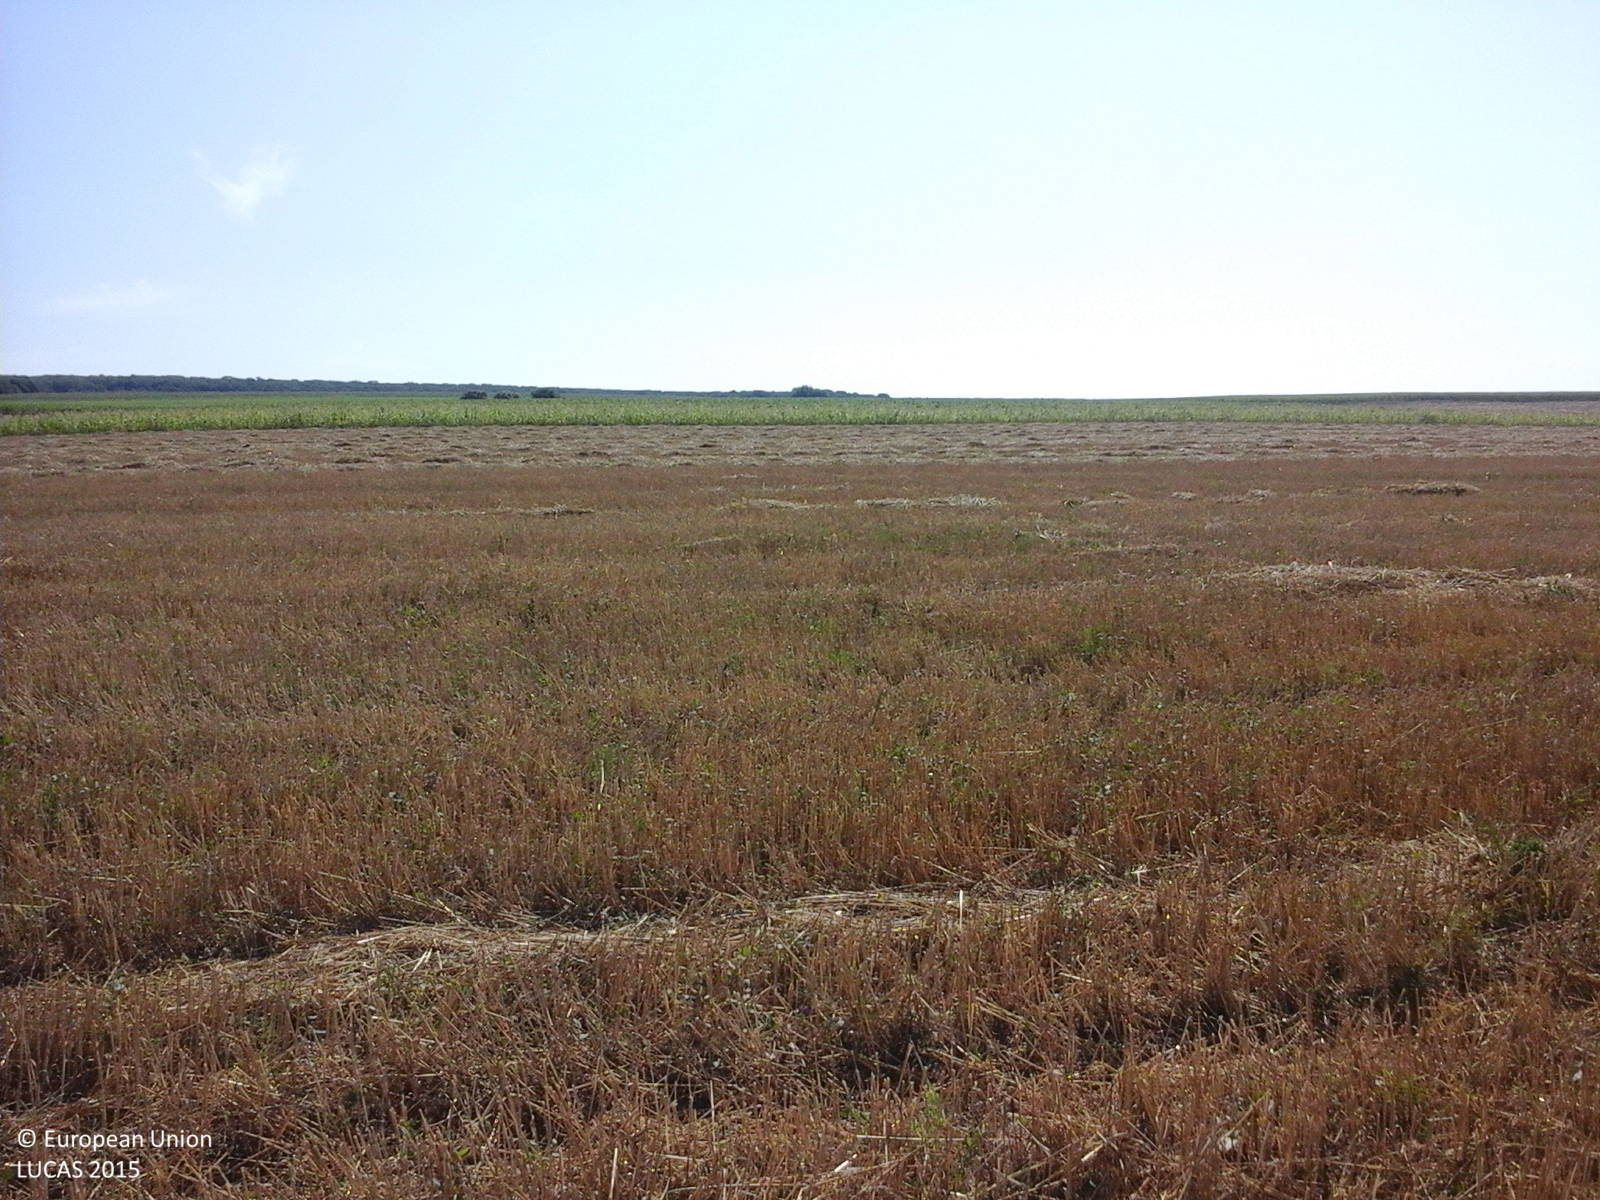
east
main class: Cropland
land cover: Common wheat
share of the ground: > 75 %
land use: Agriculture (excluding fallow land and kitchen gardens)
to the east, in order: Common wheat; Maize; Sunflower
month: July
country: RO
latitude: 46.1762
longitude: 27.3180
